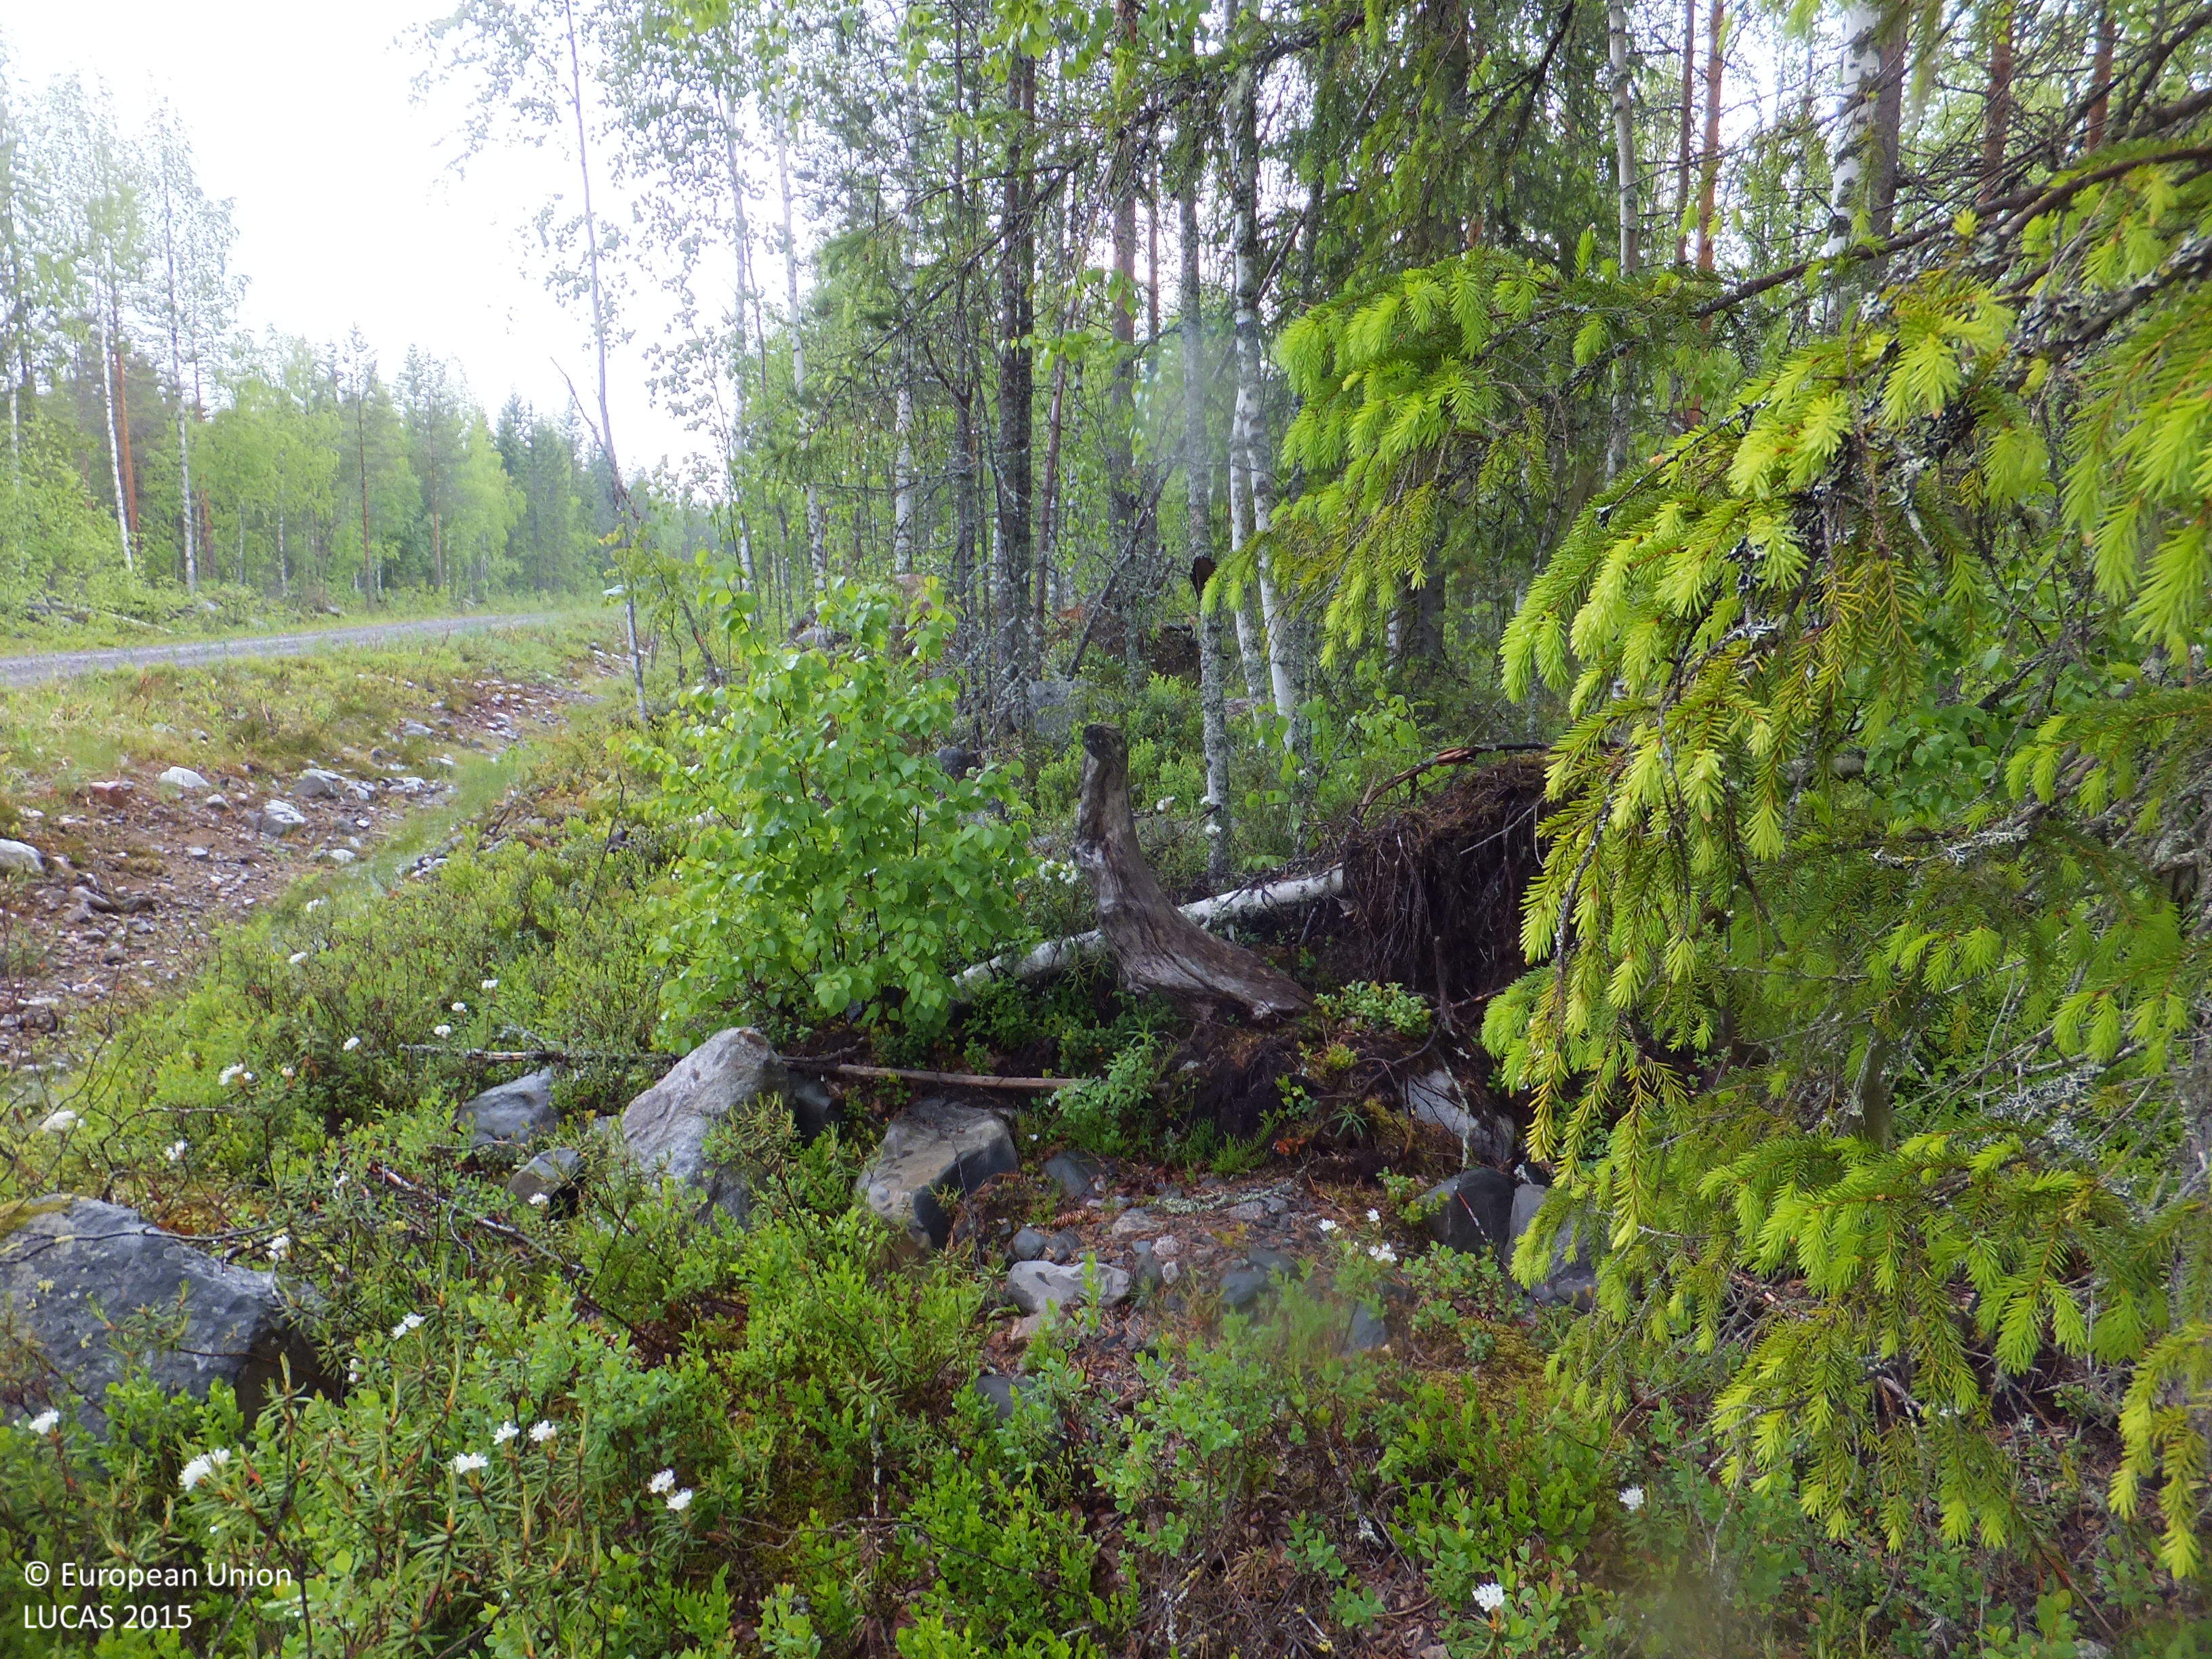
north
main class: Woodland
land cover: Pine dominated mixed woodland
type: boreal forest
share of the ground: > 75 %
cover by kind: broadleaved forest trees 45 %, coniferous forest trees 30 %, shrubs 10 %, lichens and mosses 5 %, consolidated bare surface 5 %, unconsolidated bare surface 5 %
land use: Forestry
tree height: > 5 m
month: June
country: FI
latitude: 63.7486
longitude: 24.8571
